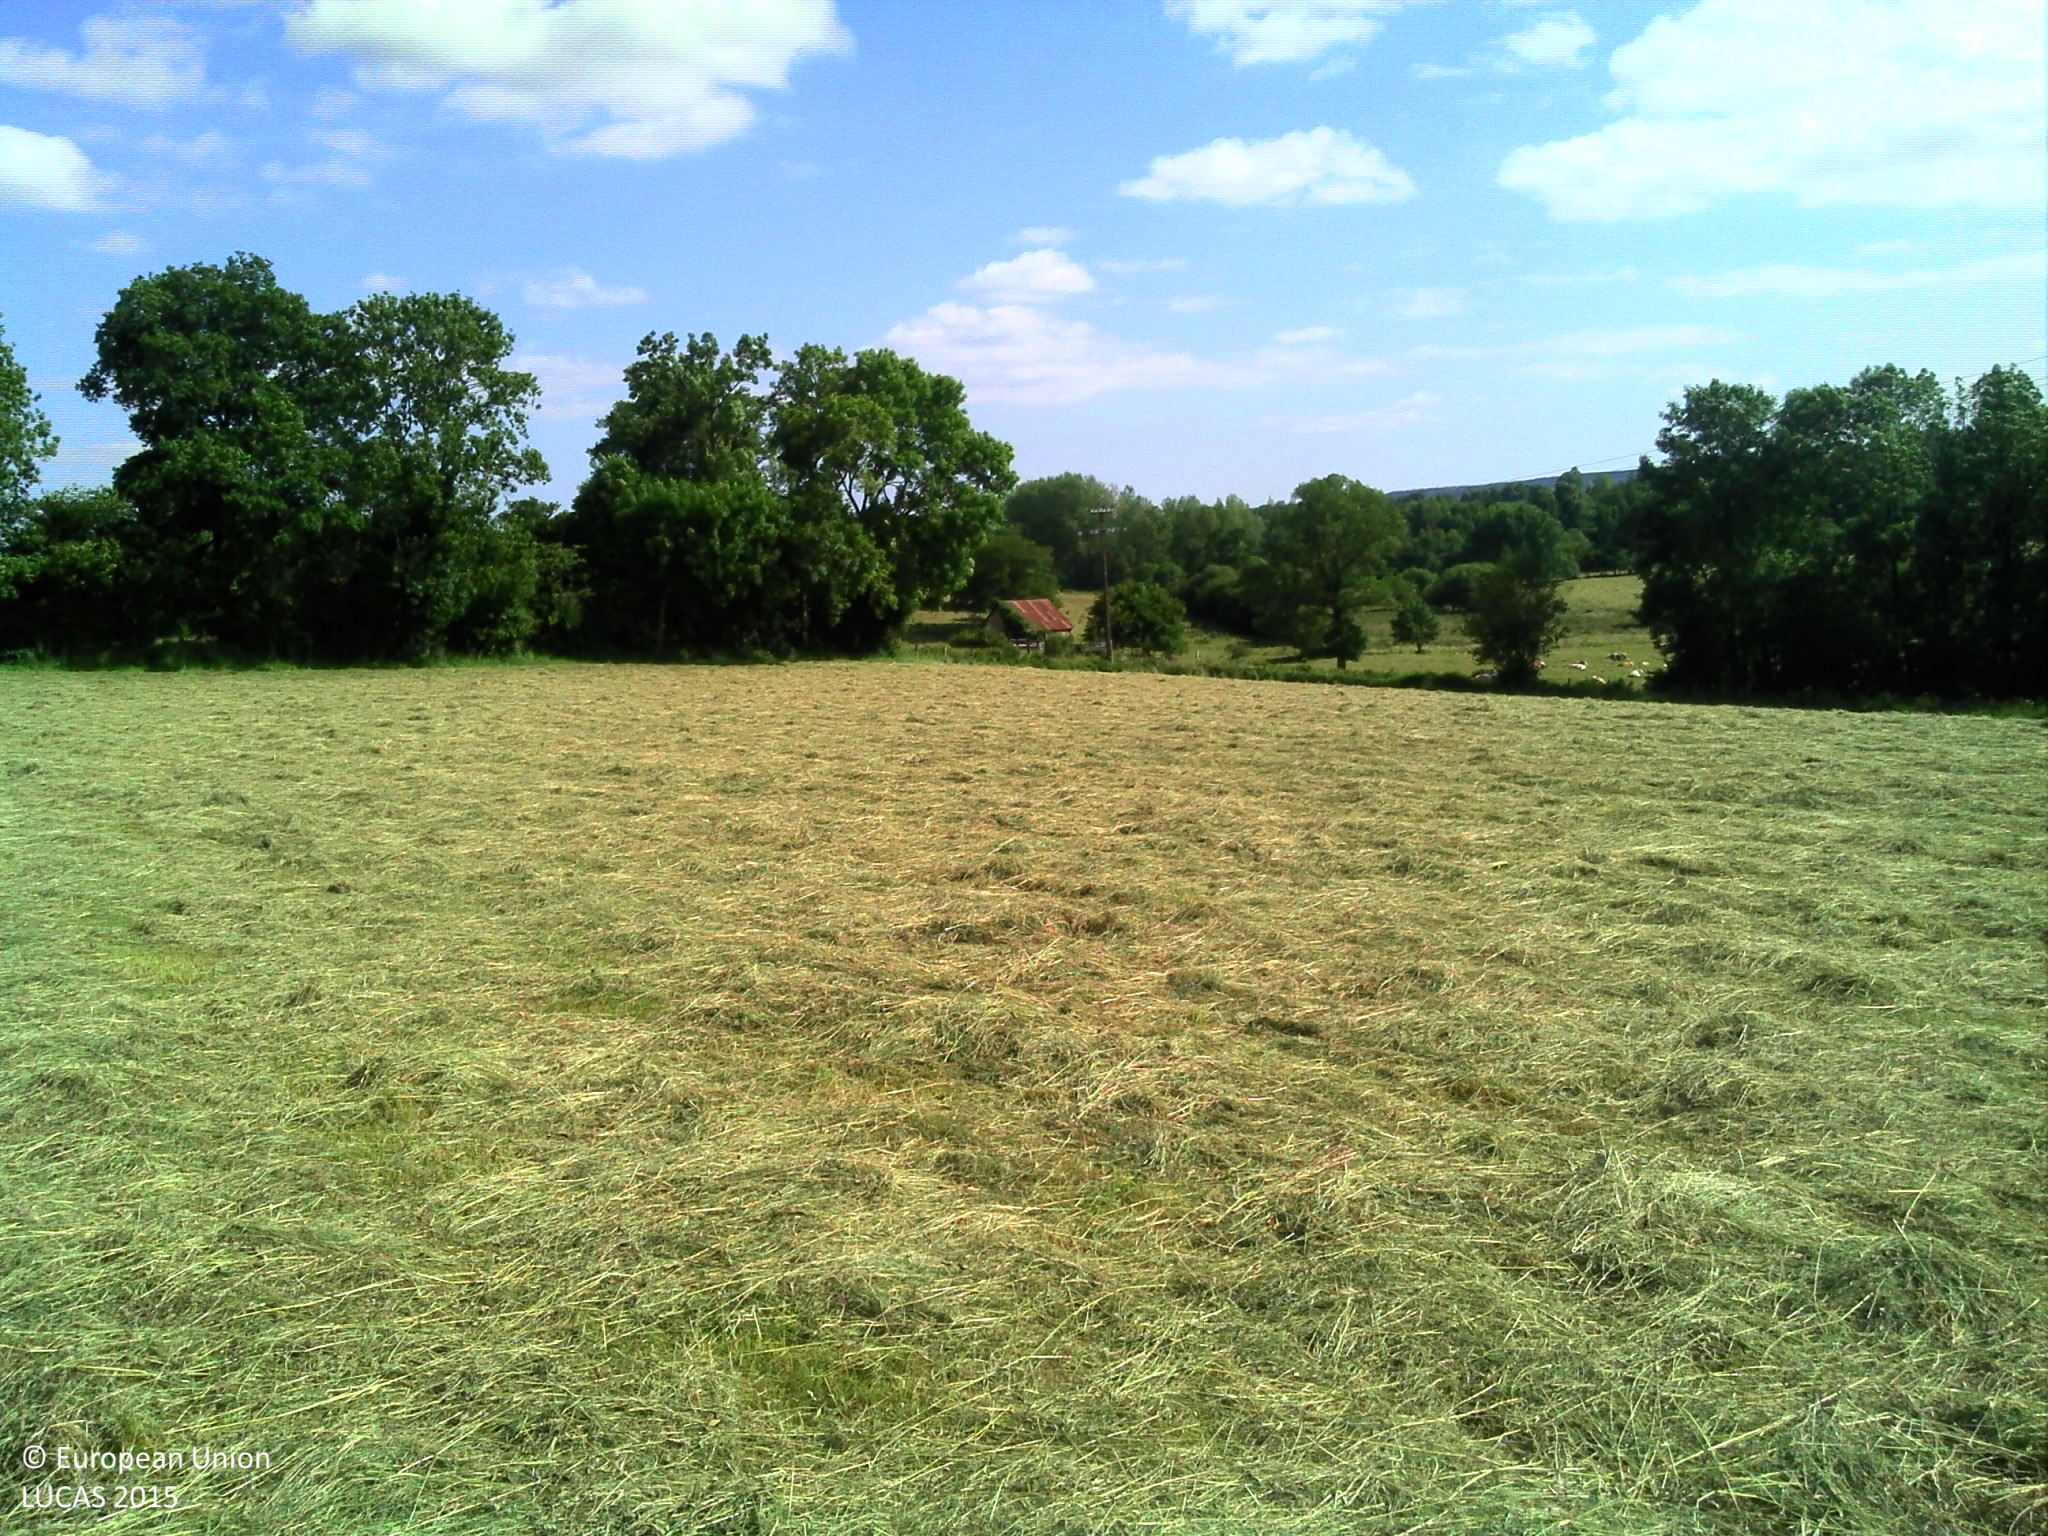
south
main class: Grassland
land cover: Grassland without tree/shrub cover
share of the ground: > 75 %
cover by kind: herbaceous plants 100 %
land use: Agriculture (excluding fallow land and kitchen gardens)
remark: Harvested field
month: June
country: FR
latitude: 48.5007
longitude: -0.1135
